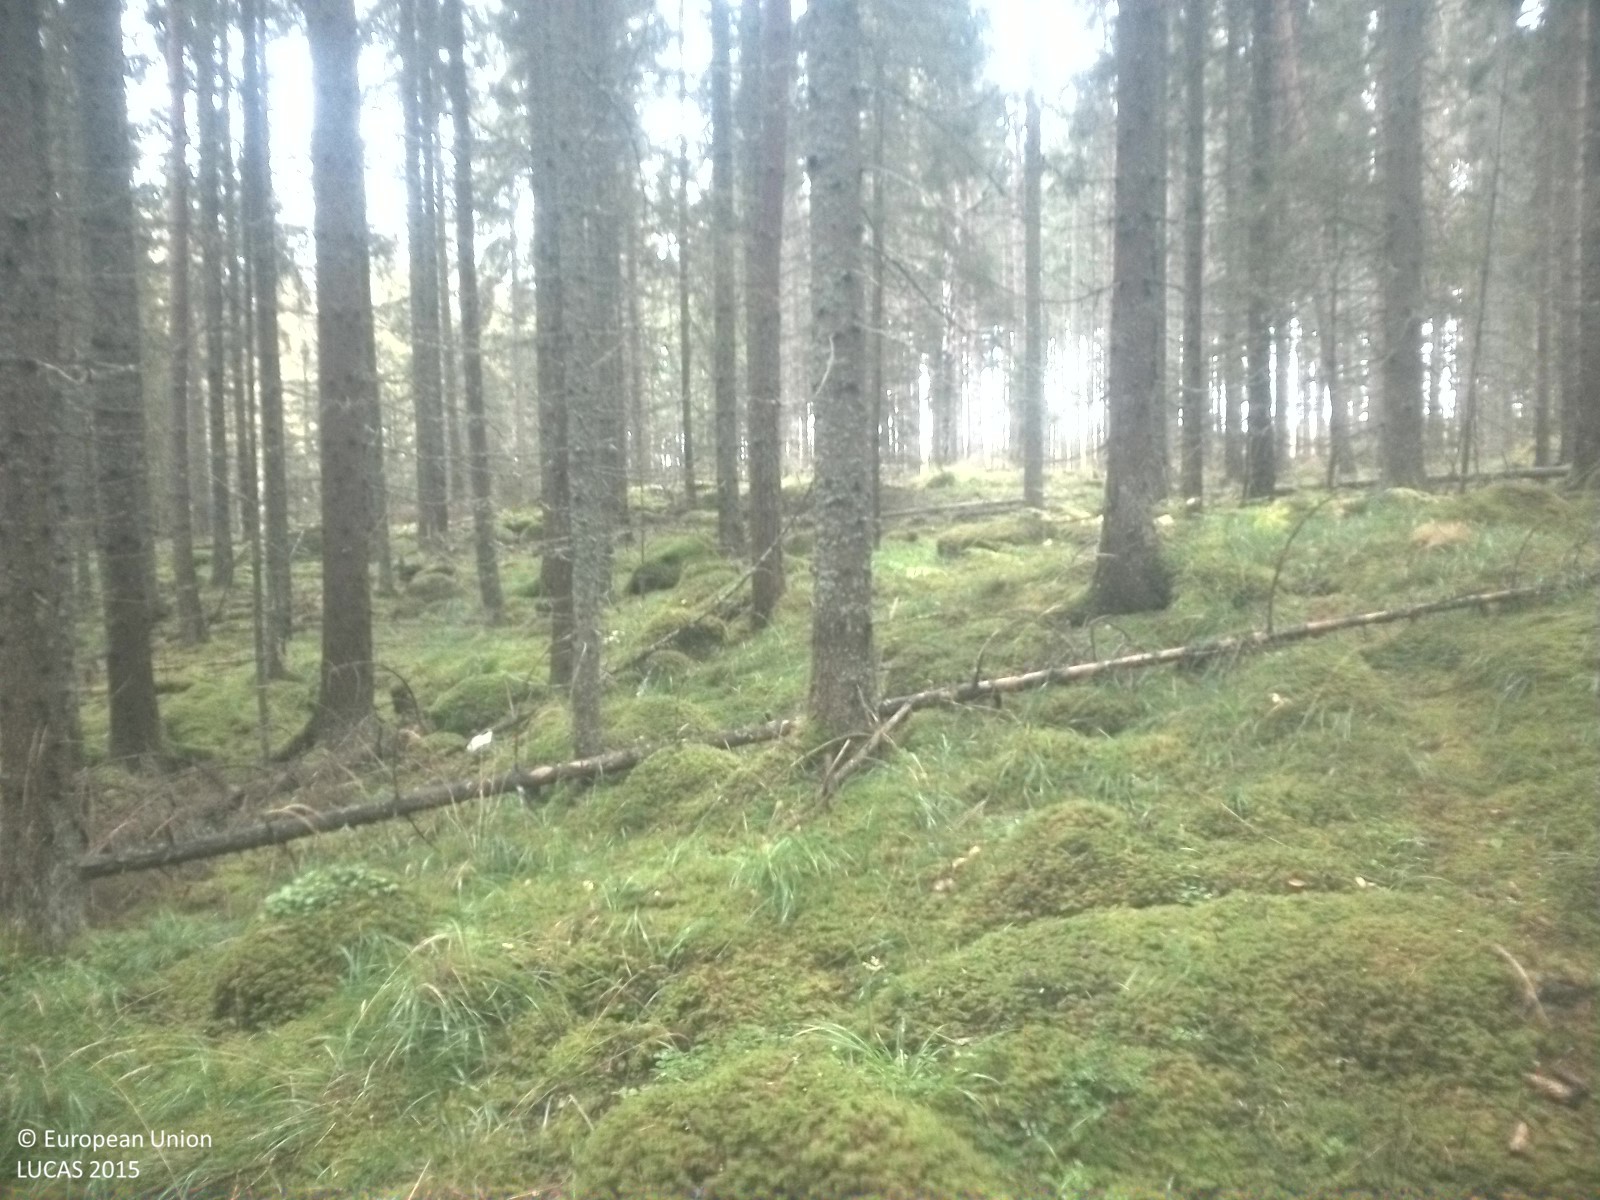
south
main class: Woodland
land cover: Spruce dominated coniferous woodland
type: boreal forest
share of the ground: 50 - 75 %
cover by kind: coniferous forest trees 55 %, lichens and mosses 40 %, herbaceous plants 5 %
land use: Forestry
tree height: > 5 m
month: September
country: SE
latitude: 58.8357
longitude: 15.7627
